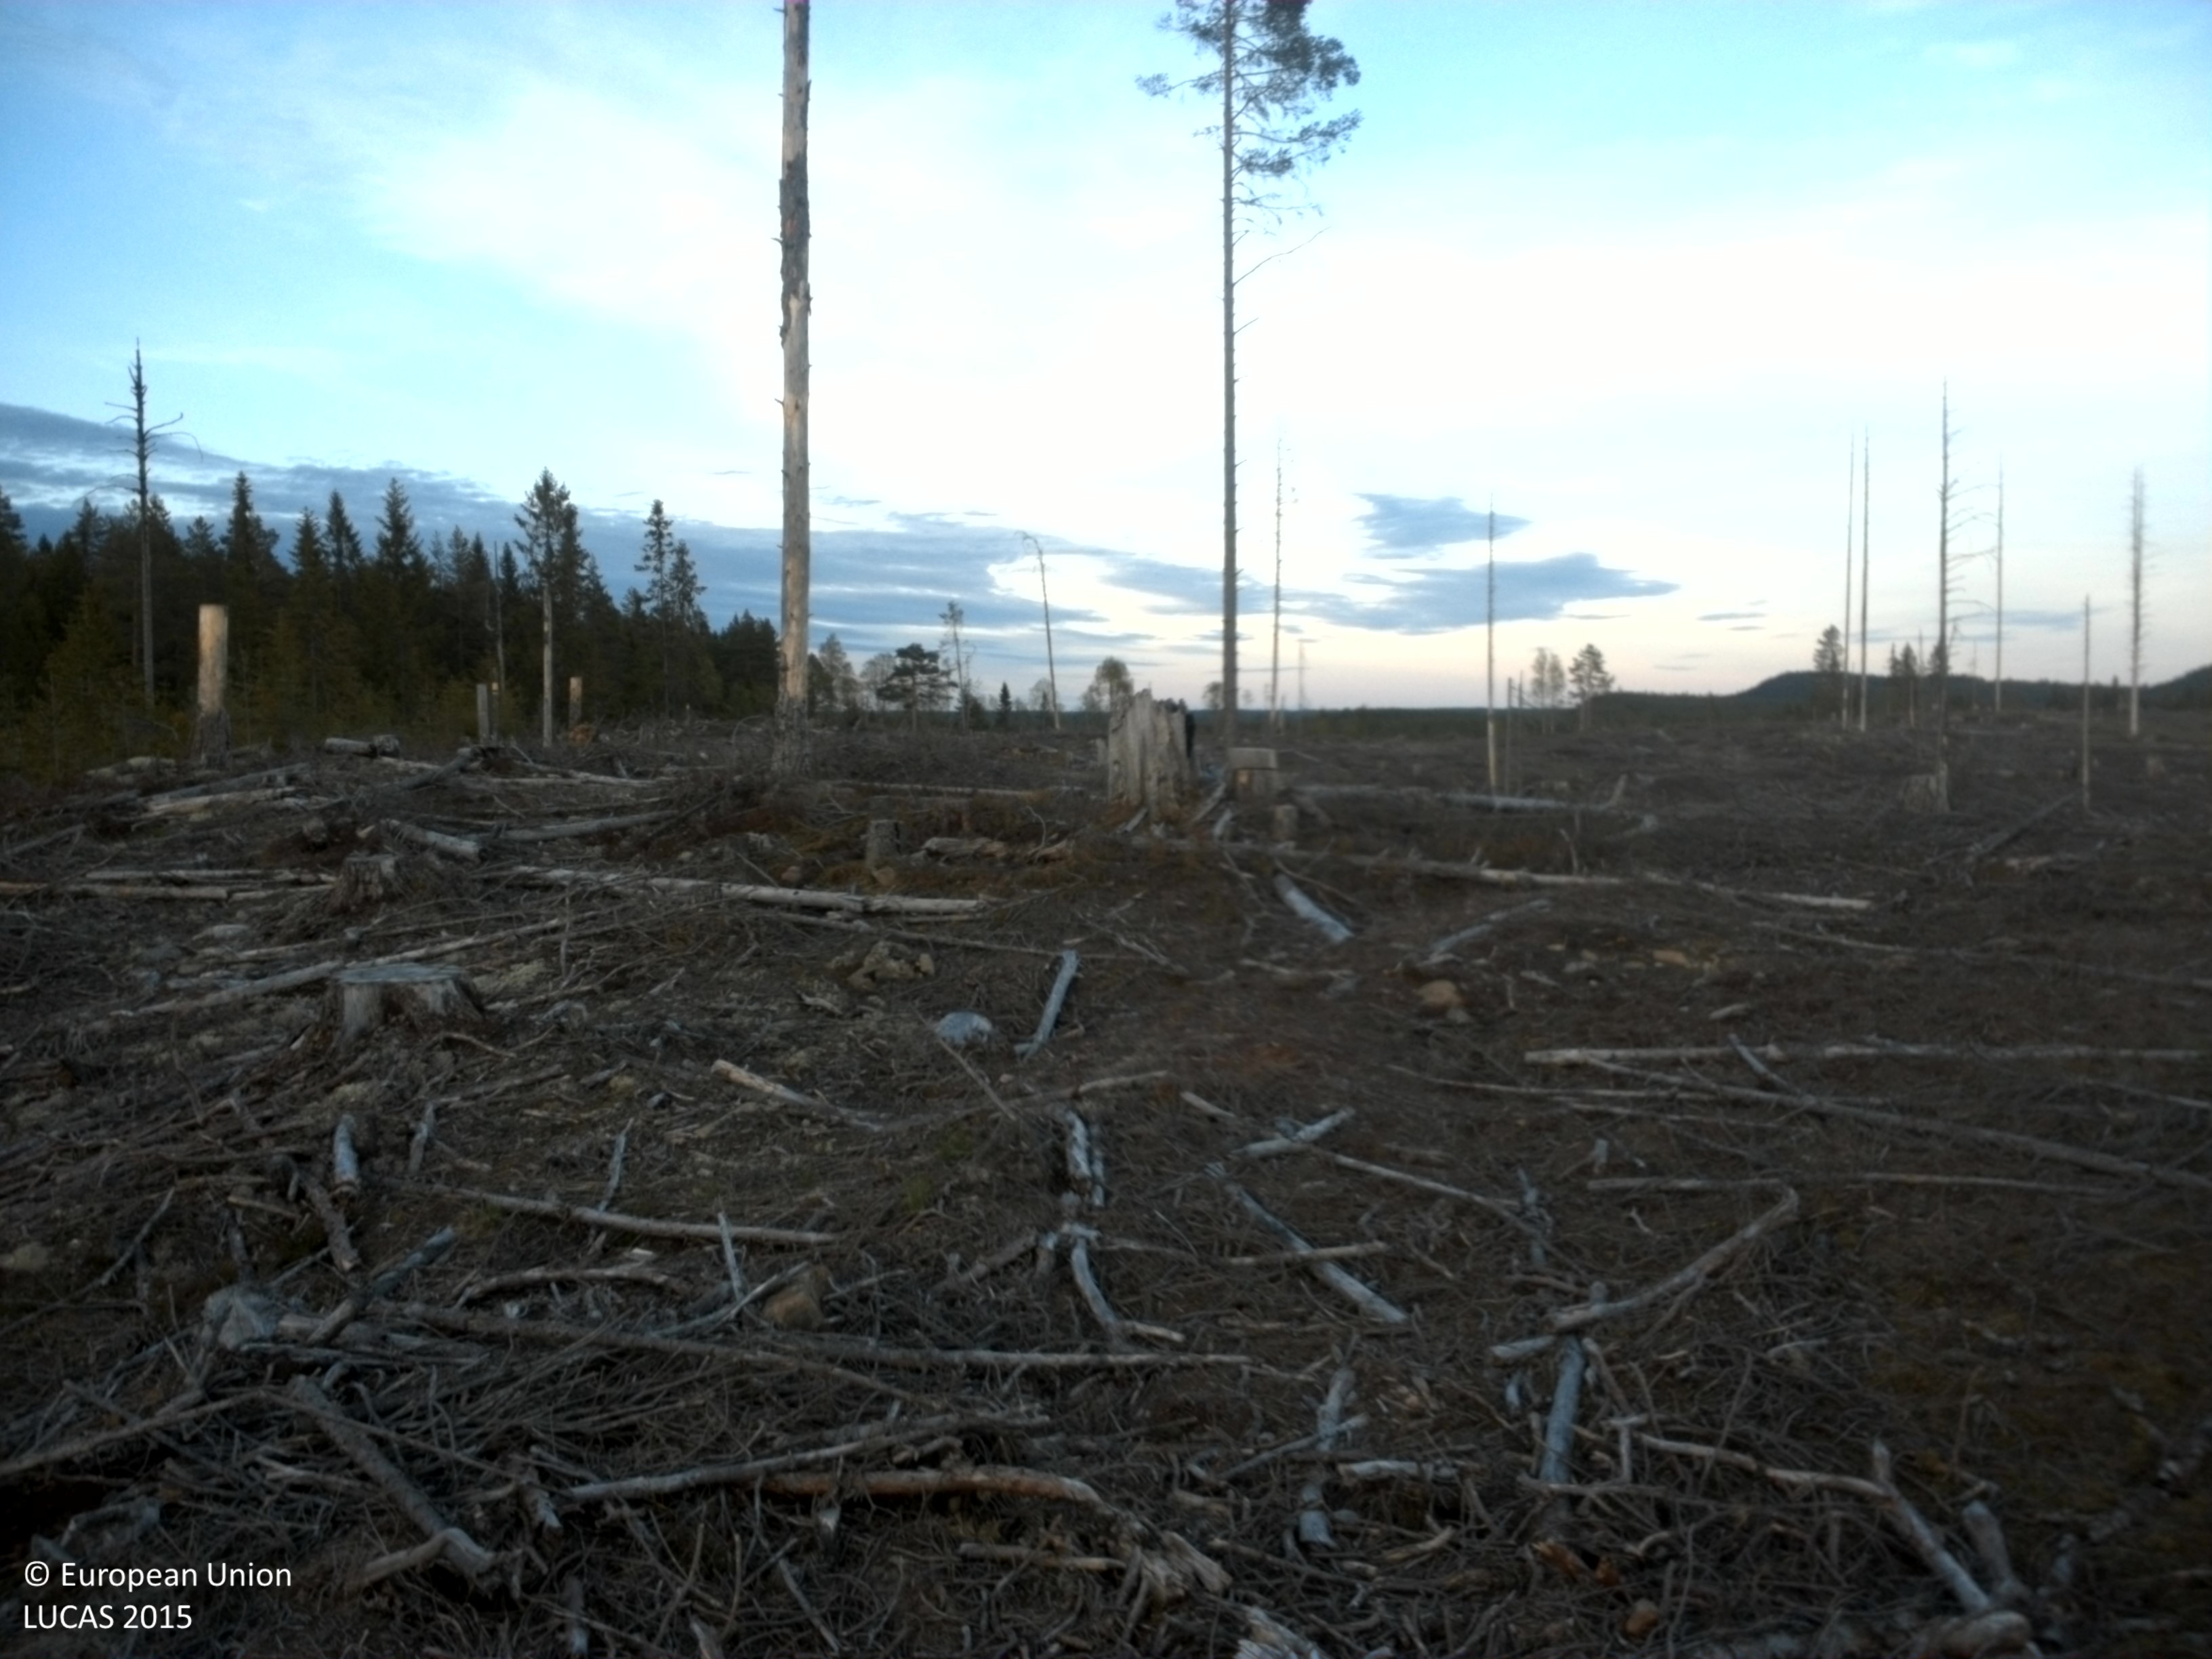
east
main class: Shrubland
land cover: Shrubland with sparse tree cover
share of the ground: 50 - 75 %
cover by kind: shrubs 55 %, lichens and mosses 10 %, consolidated bare surface 10 %, coniferous forest trees 5 %
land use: Forestry
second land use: Amenities, museums, leisure
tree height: > 5 m
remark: Clear cut
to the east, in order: Shrubland with sparse tree cover; Grassland without tree/shrub cover; Spruce dominated mixed woodland; Ditches and canals; Spruce dominated coniferous woodland; Grassland without tree/shrub cover
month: June
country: SE
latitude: 61.1321
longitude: 13.3494
